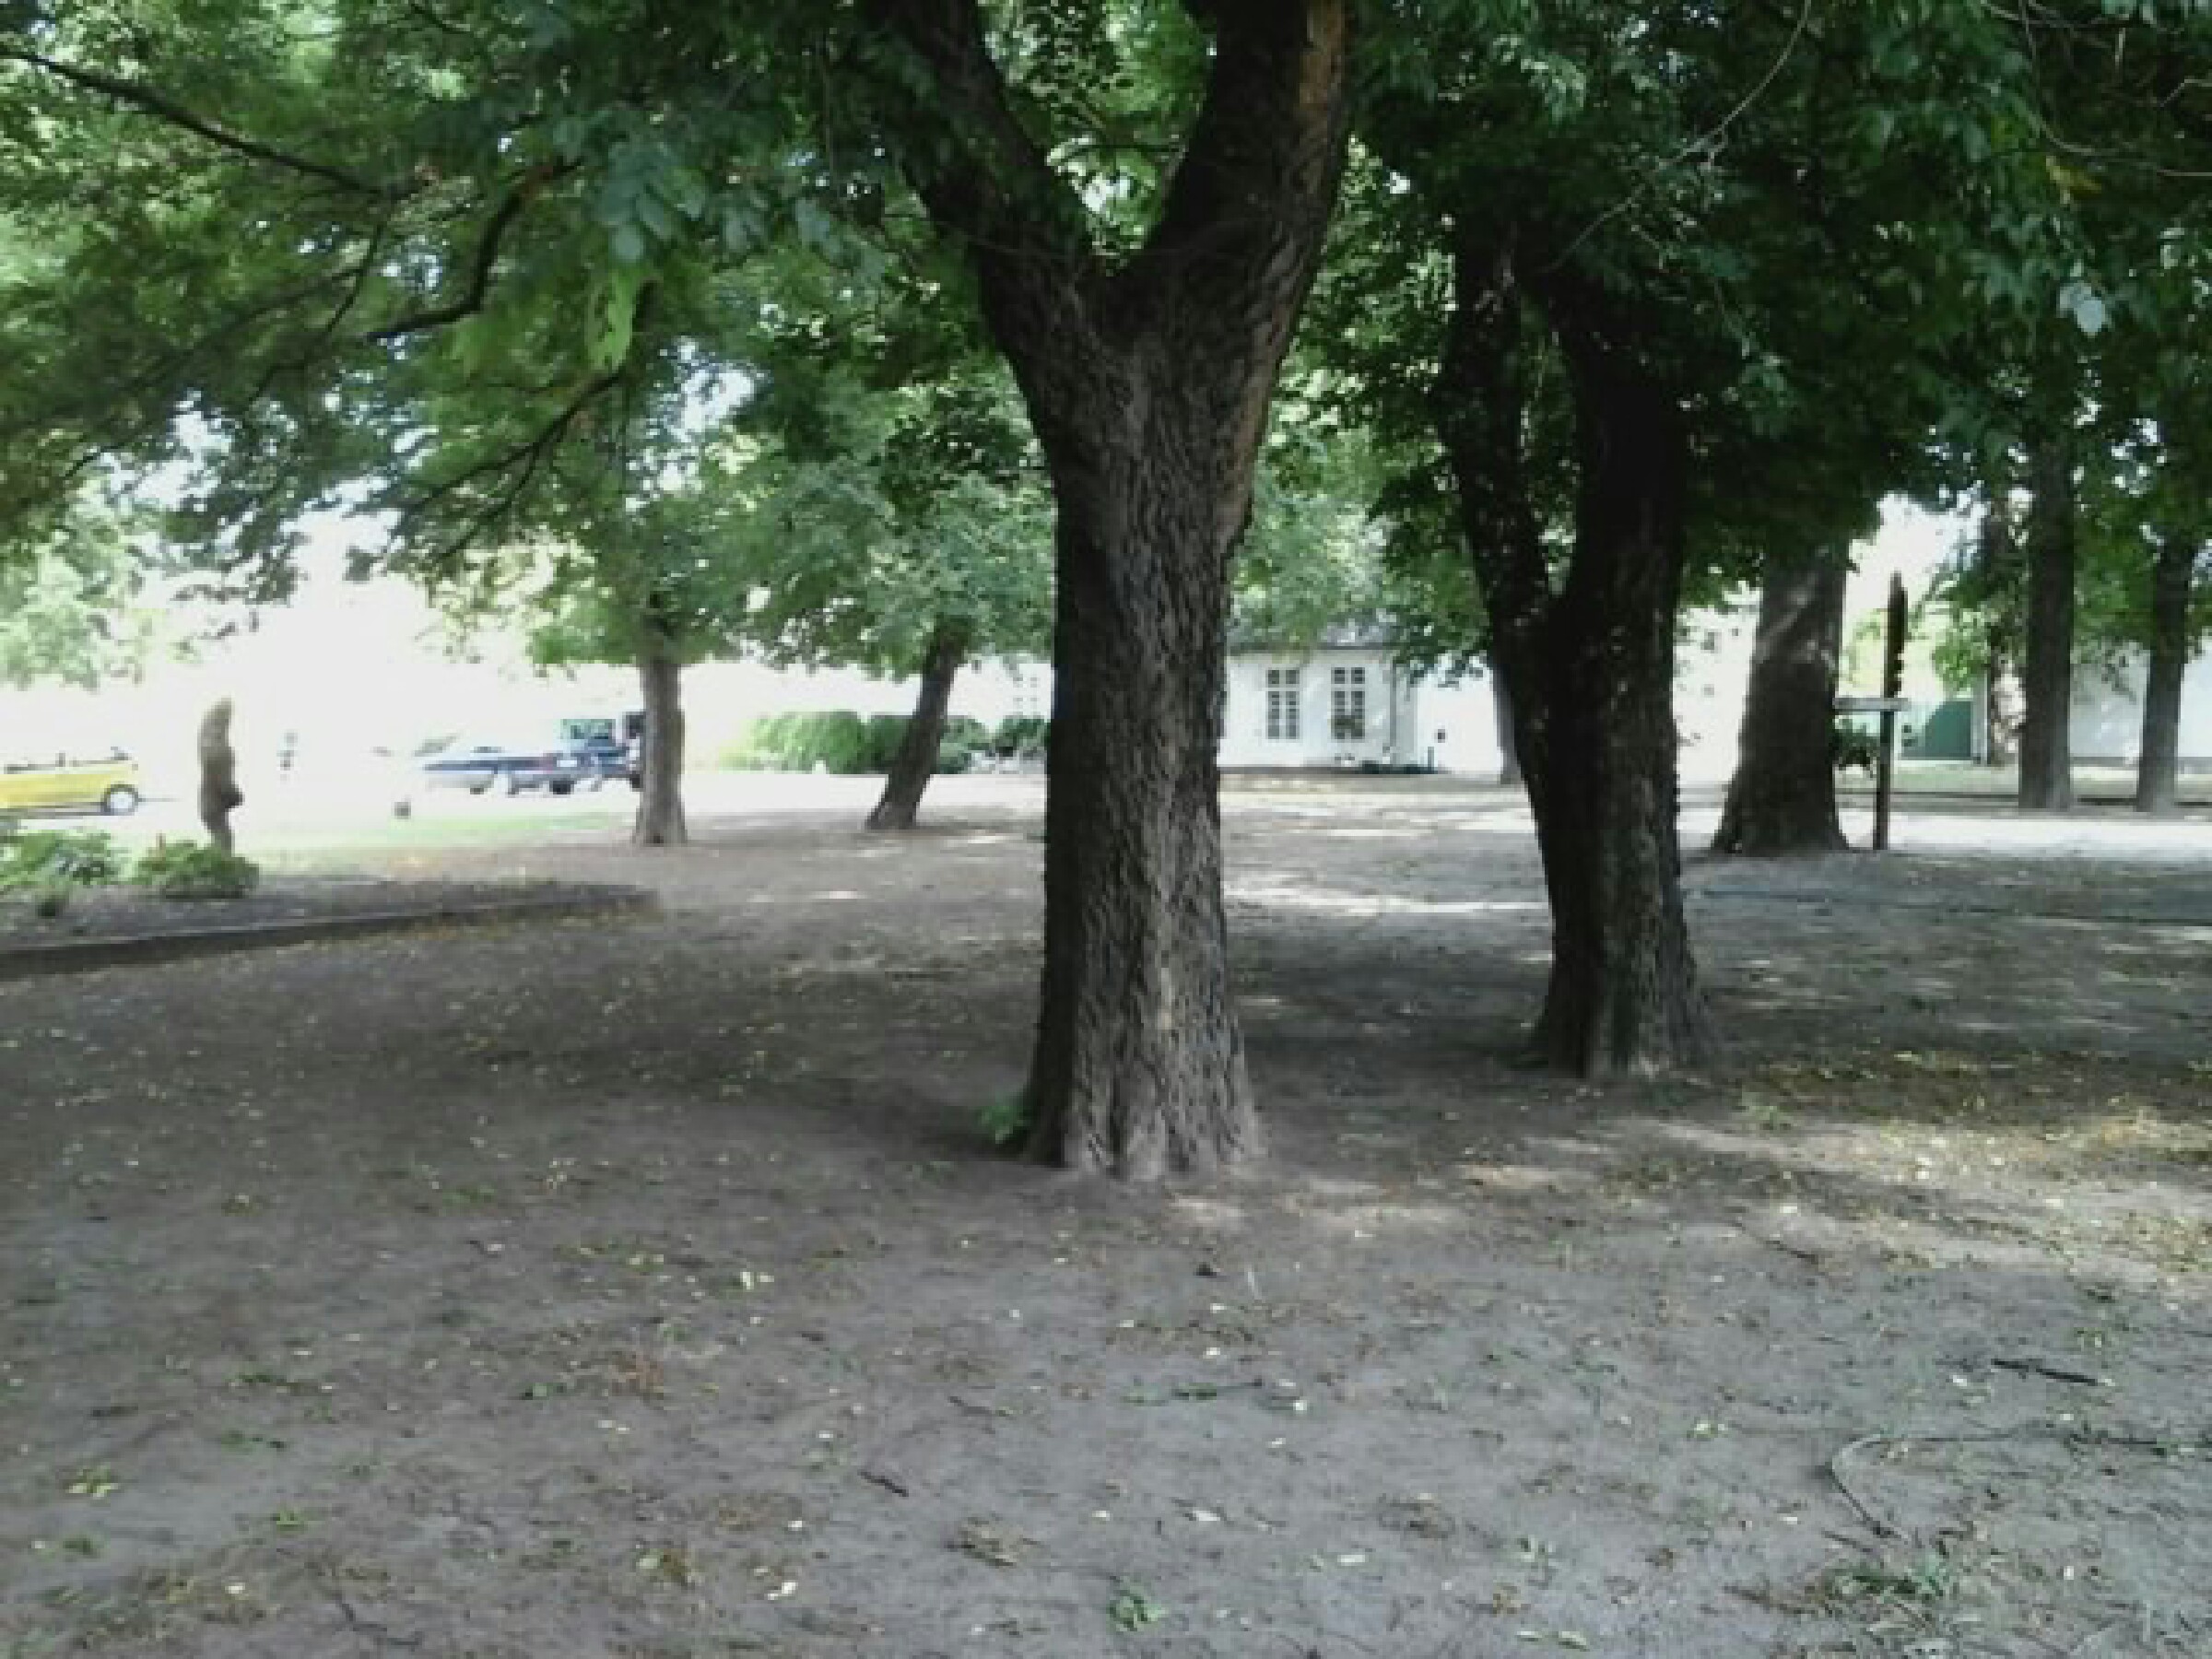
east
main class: Woodland
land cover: Broadleaved woodland
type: mesophytic deciduous forest
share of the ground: > 75 %
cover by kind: broadleaved forest trees 95 %, herbaceous plants 5 %
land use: Amenities, museums, leisure
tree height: > 5 m
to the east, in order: Broadleaved woodland; Artificial constructions in urban areas
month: July
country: HU
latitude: 47.6799
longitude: 19.1438
